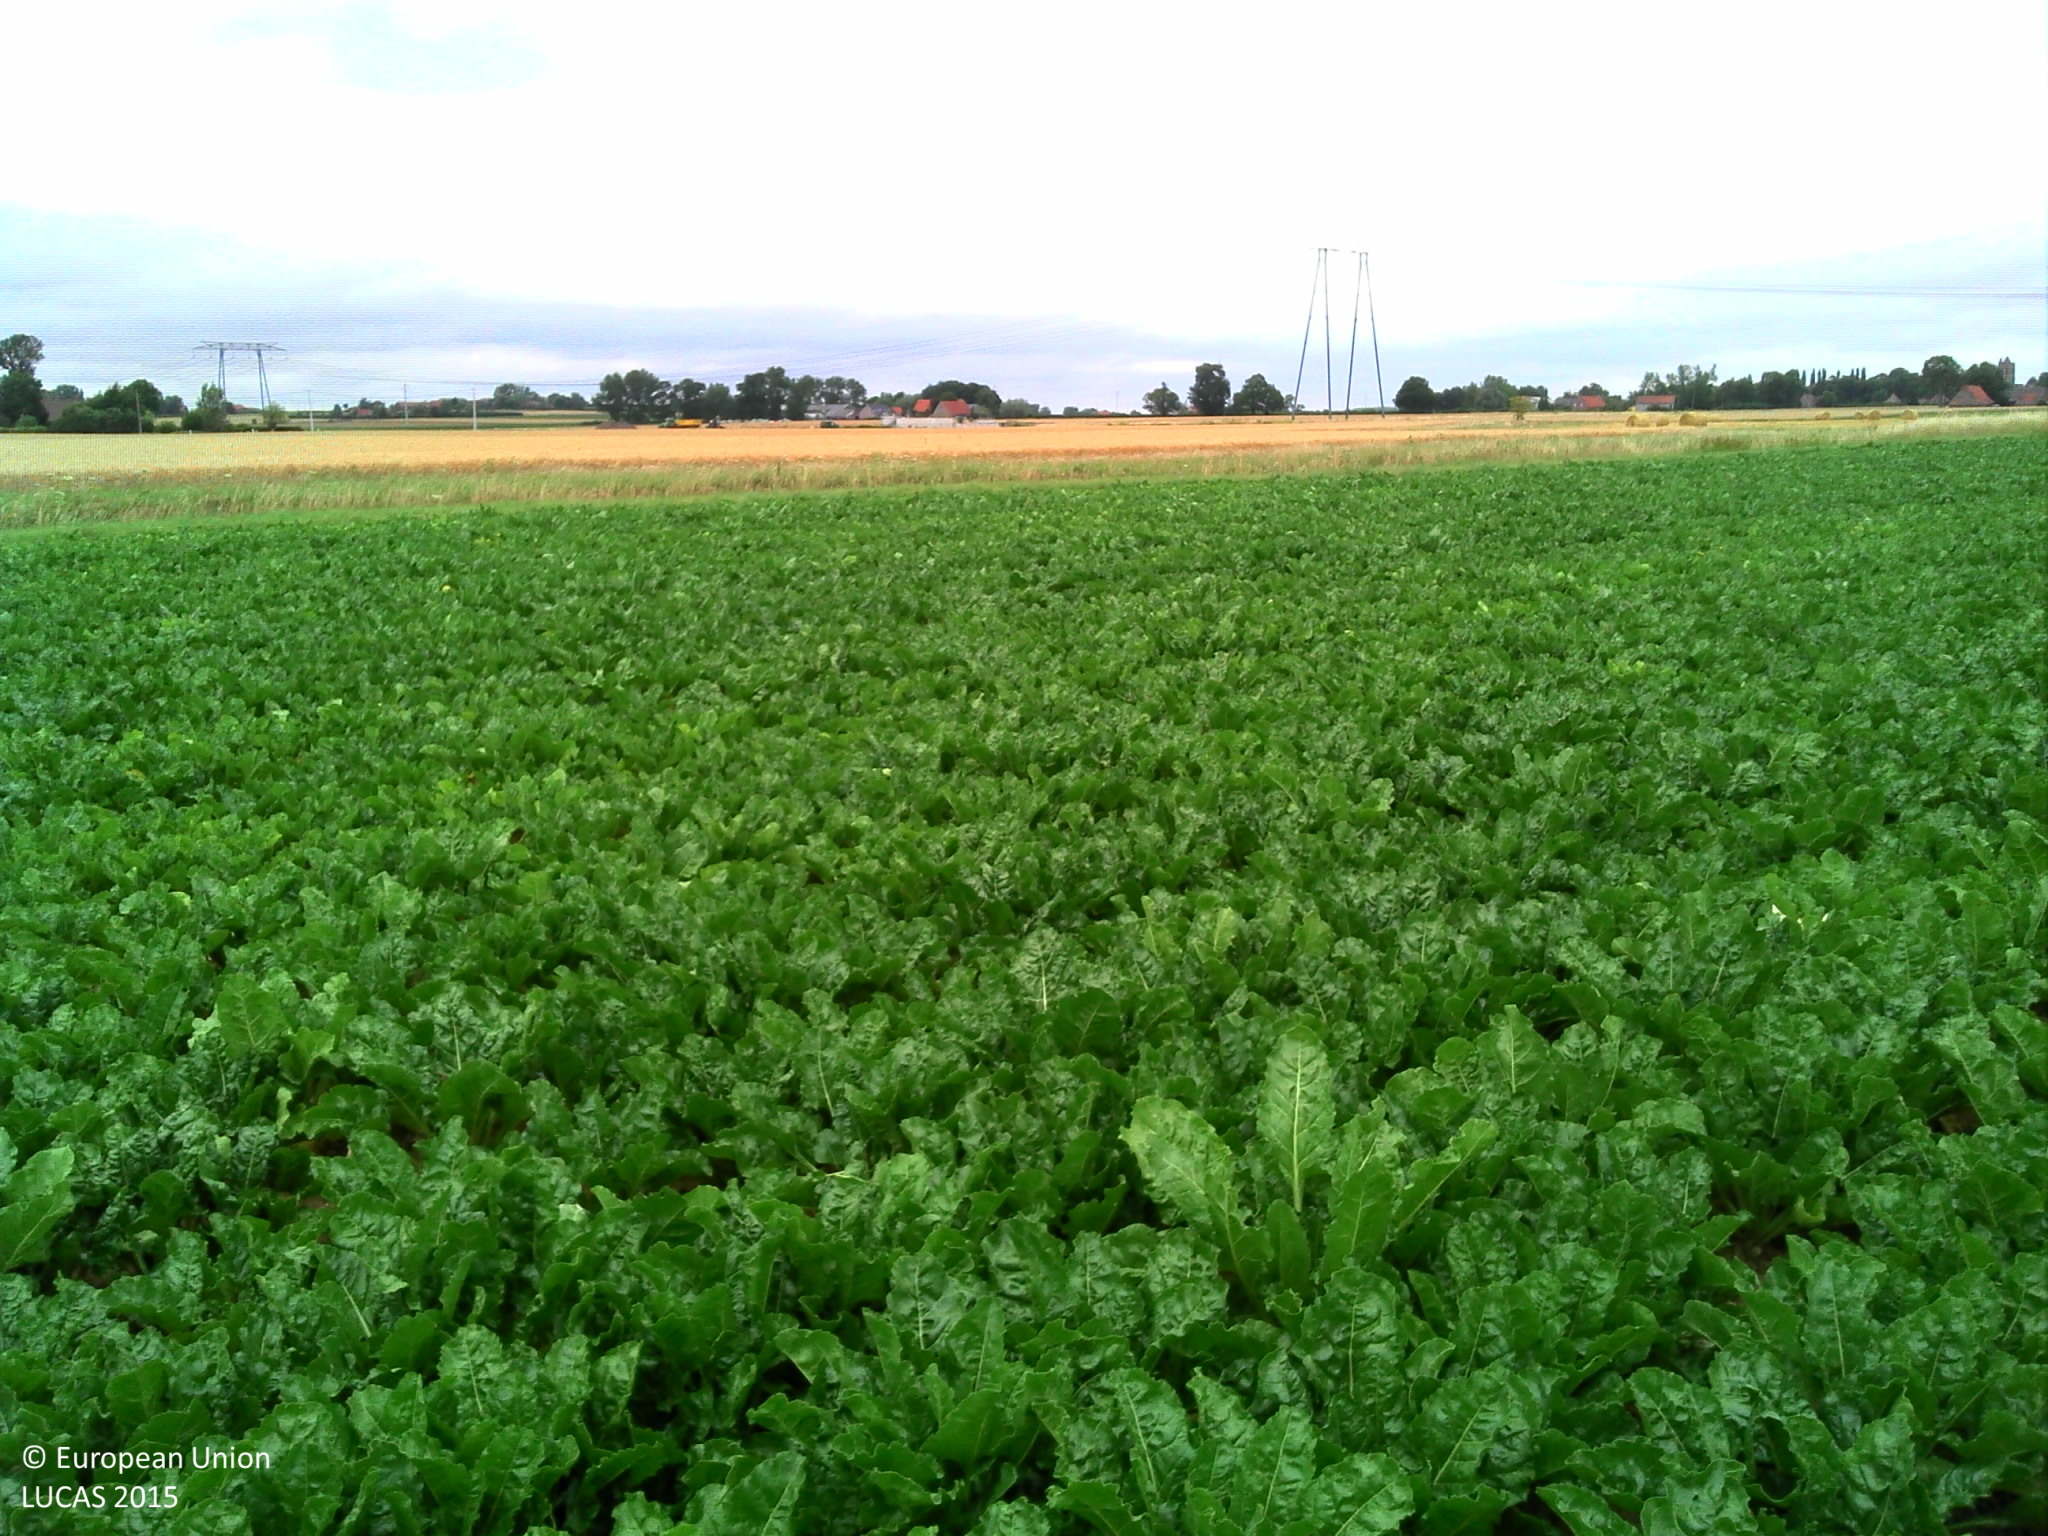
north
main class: Cropland
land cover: Sugar beet
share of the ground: > 75 %
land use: Agriculture (excluding fallow land and kitchen gardens)
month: July
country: FR
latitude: 50.8291
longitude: 2.3338
